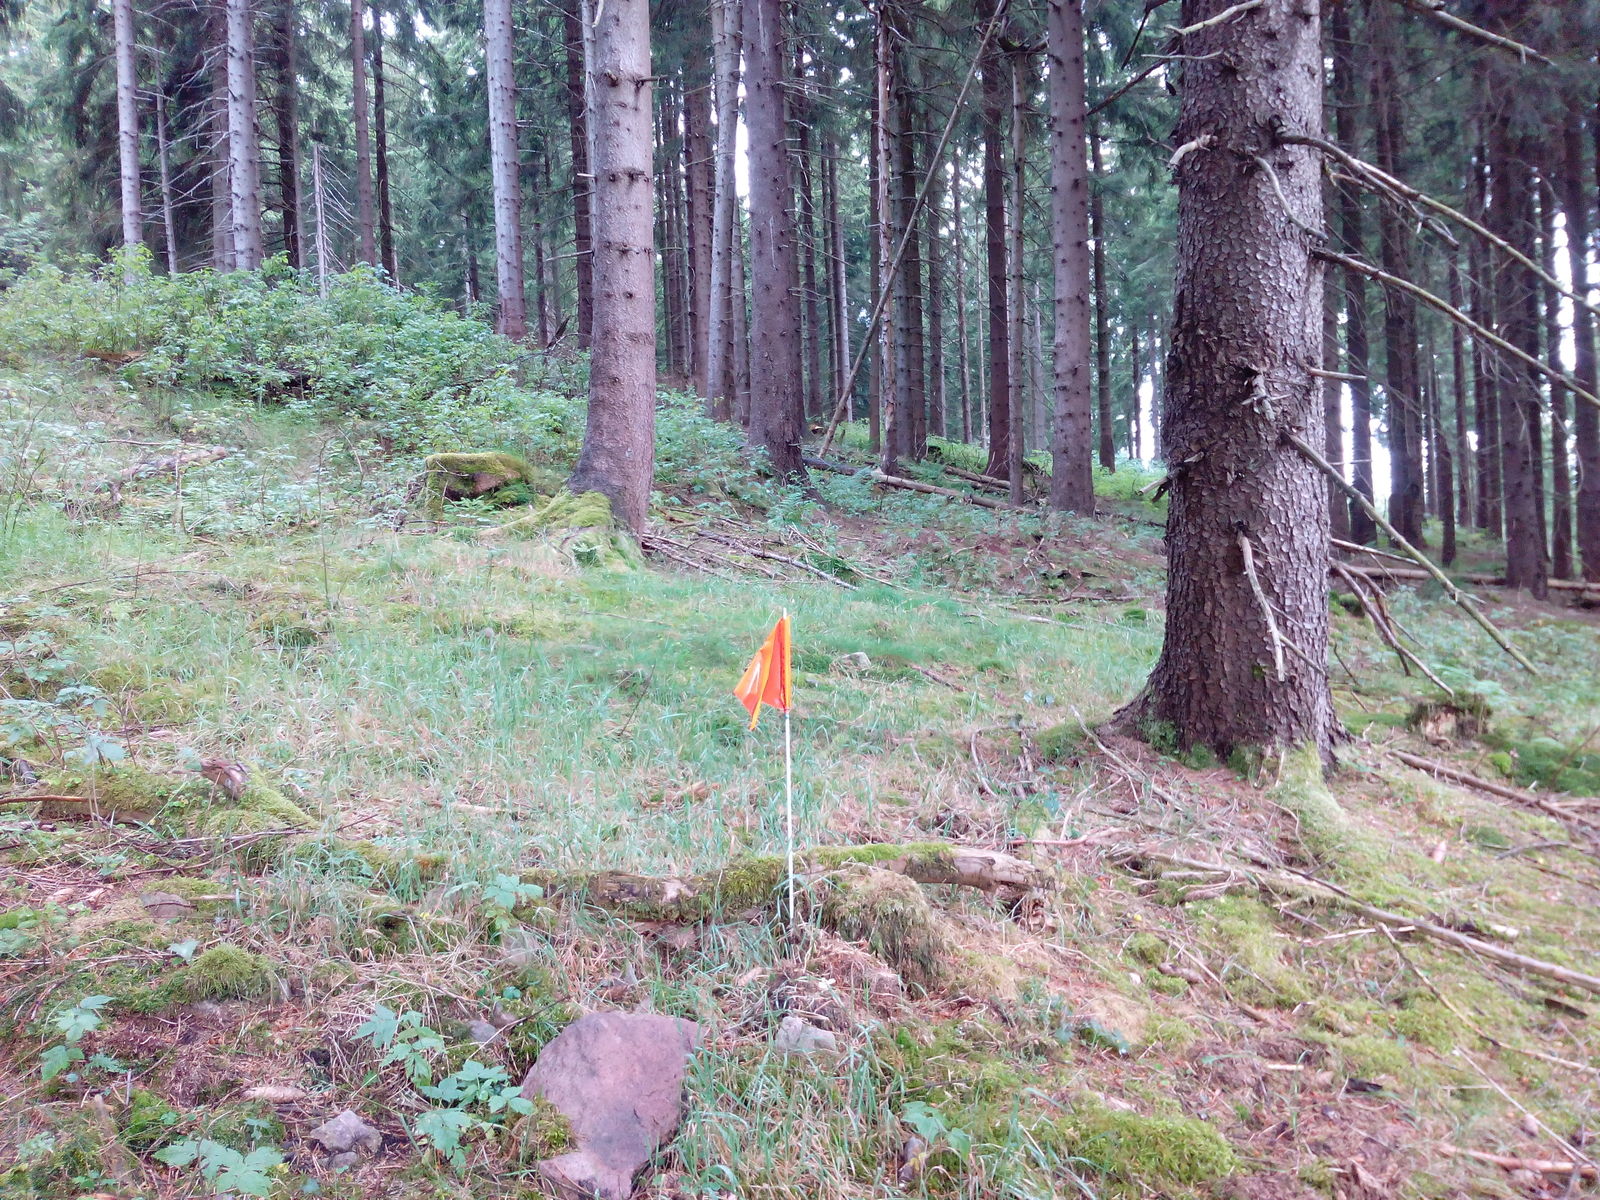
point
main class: Woodland
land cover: Spruce dominated coniferous woodland
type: hemiboreal forest and nemoral coniferous forest and mixed broadleaved-coniferous forest
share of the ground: > 75 %
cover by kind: coniferous forest trees 85 %, herbaceous plants 10 %, shrubs 5 %
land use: Forestry
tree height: > 5 m
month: July
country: DE
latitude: 50.6298
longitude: 10.9469
